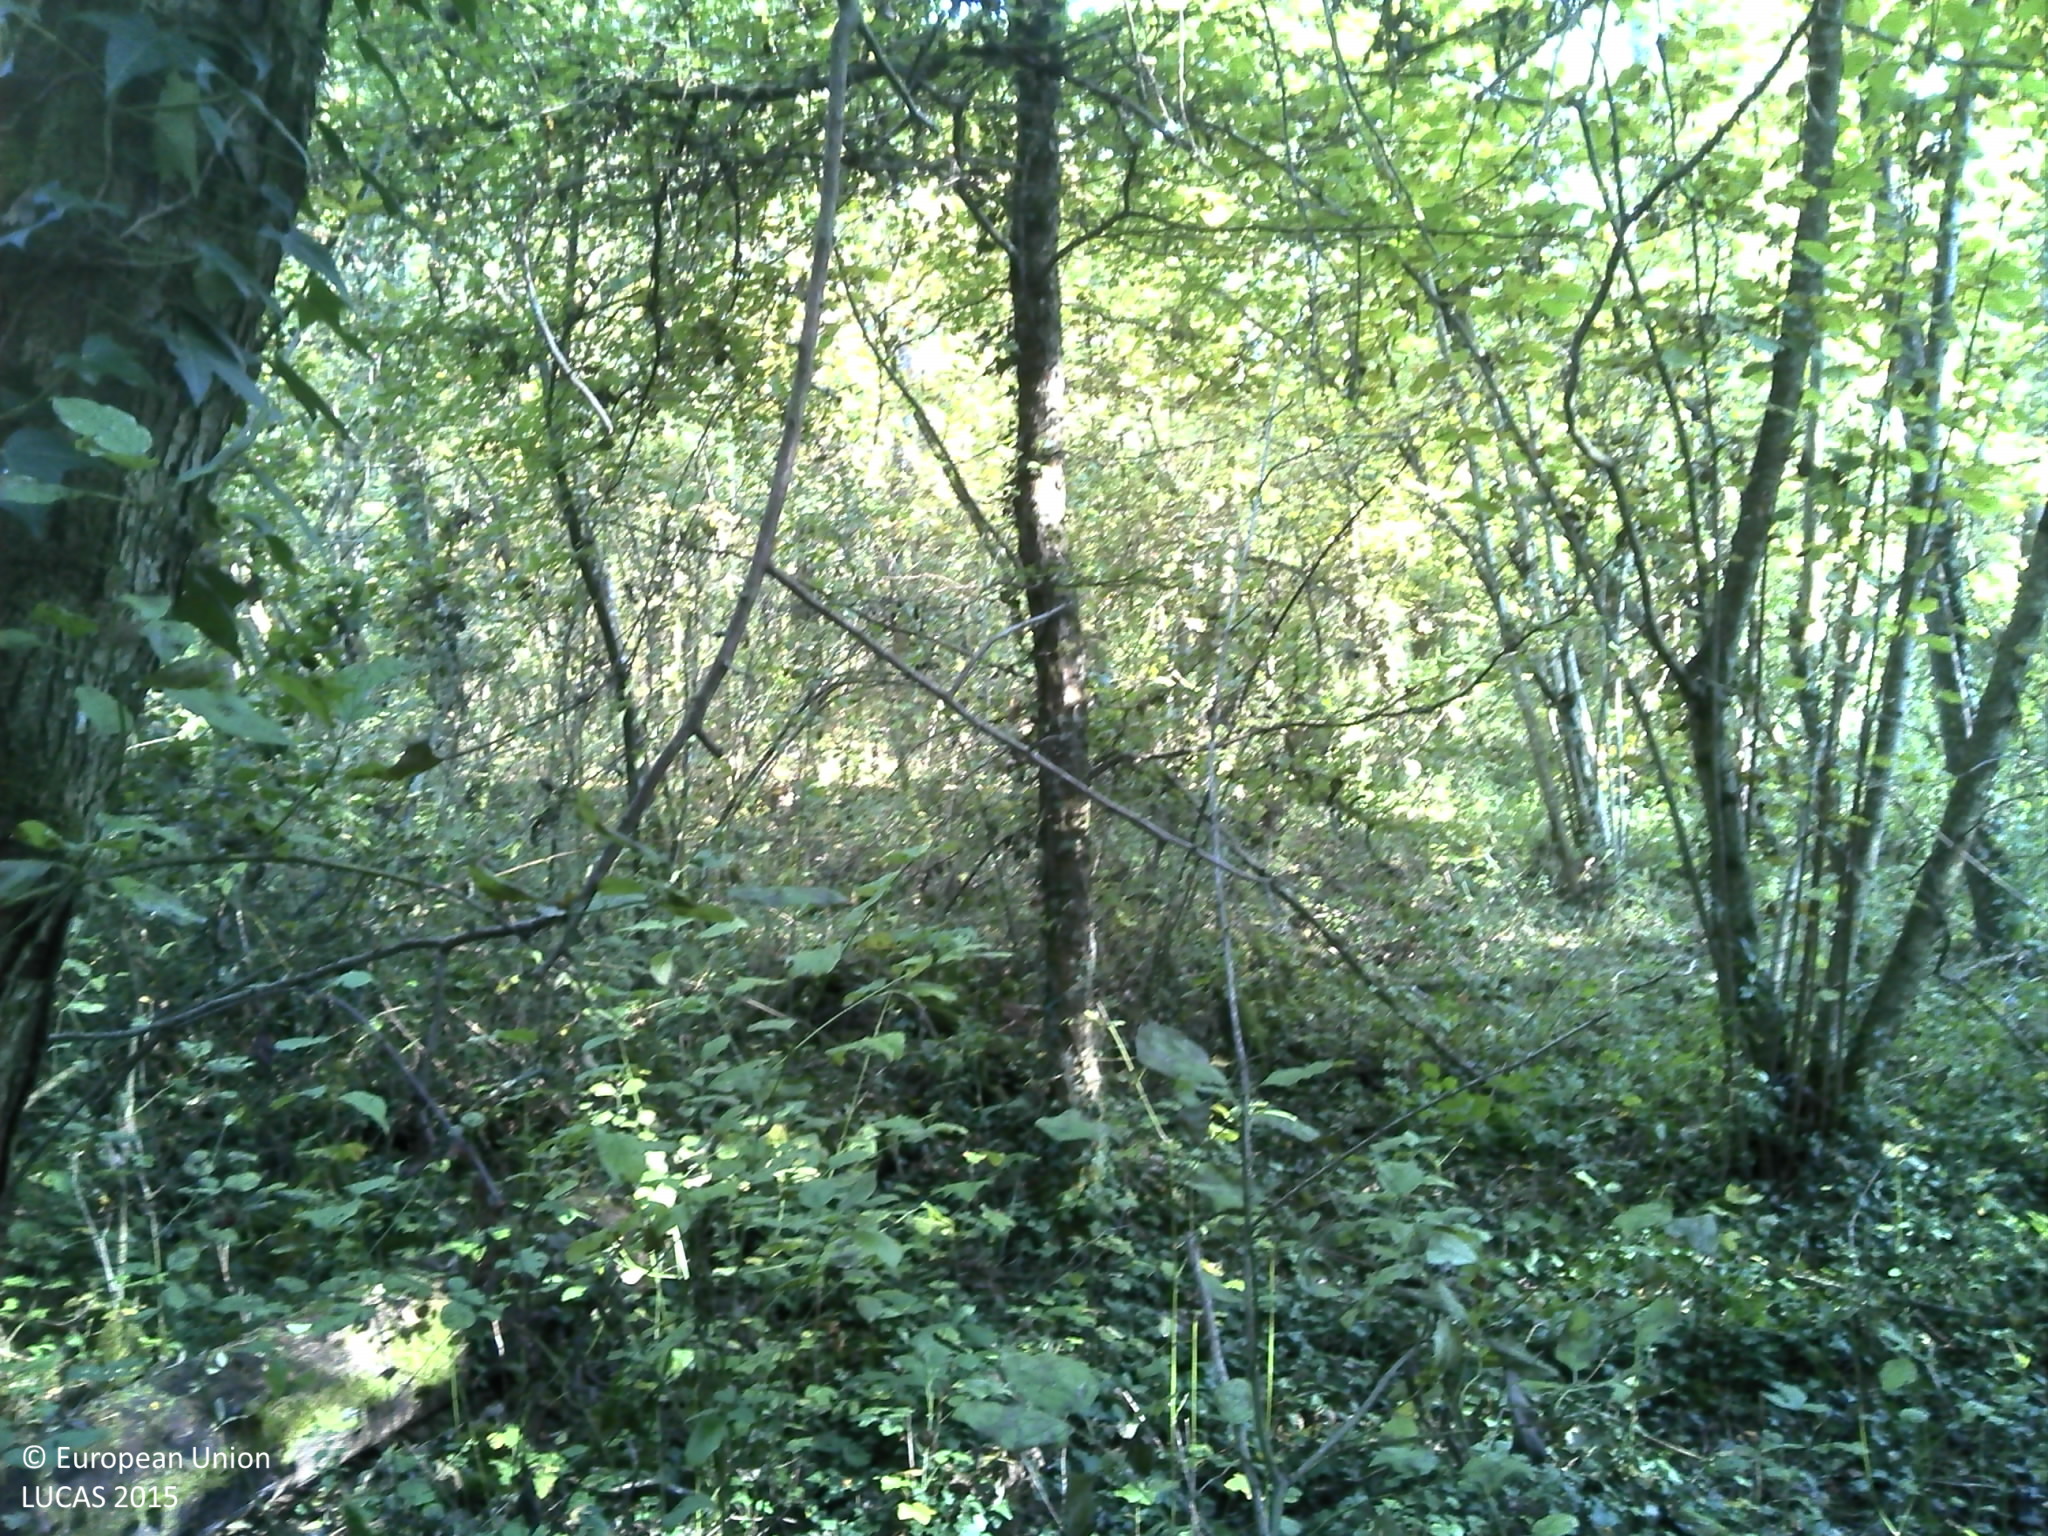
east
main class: Woodland
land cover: Broadleaved woodland
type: mesophytic deciduous forest
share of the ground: > 75 %
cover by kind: broadleaved forest trees 100 %
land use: Forestry
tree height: > 5 m
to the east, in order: Broadleaved woodland; Spontaneously vegetated surfaces; Arable land (only in case pi); Broadleaved woodland
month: October
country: FR
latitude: 47.1854
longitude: 5.2899
